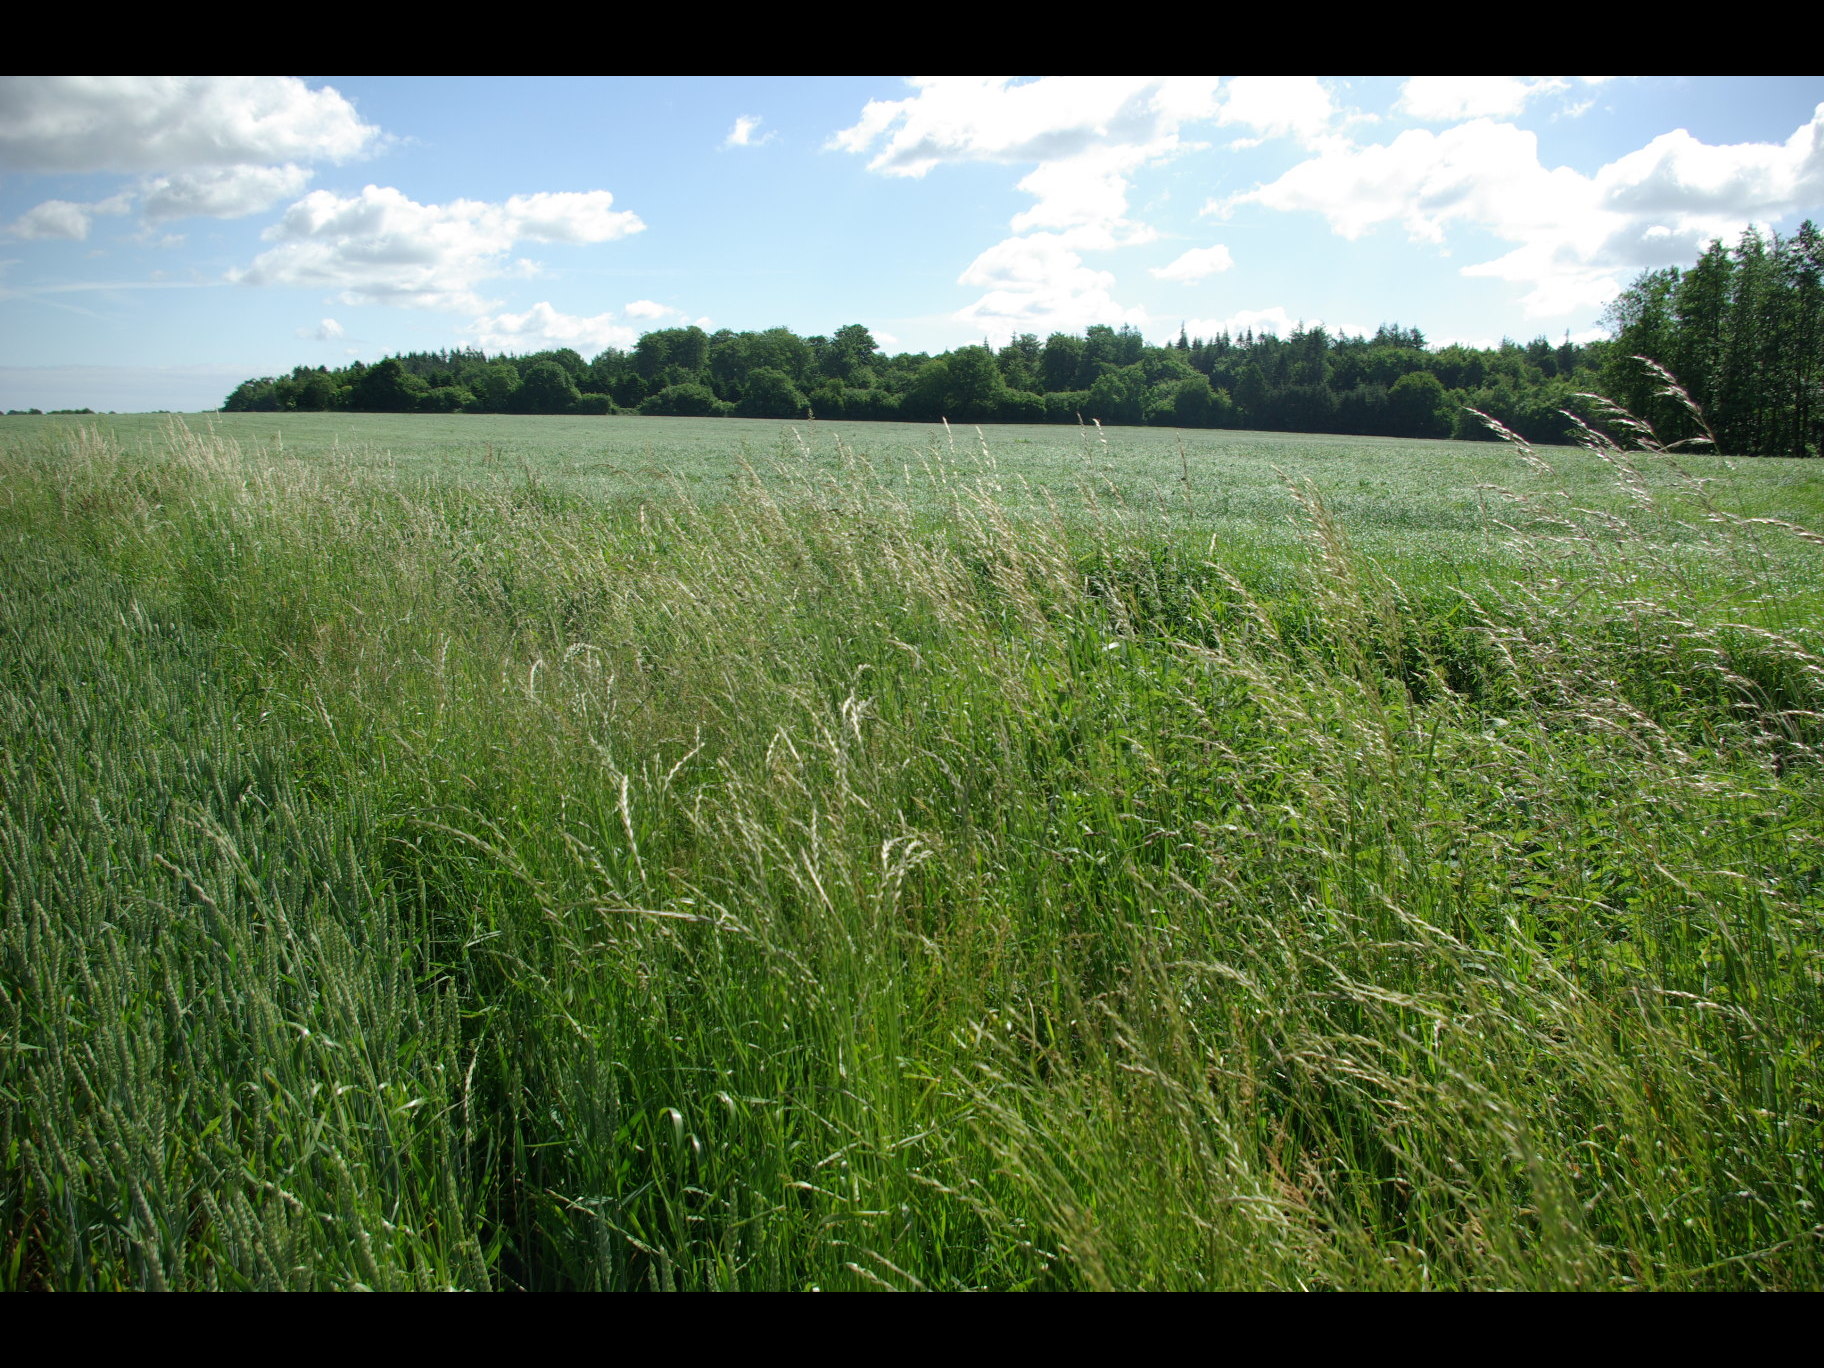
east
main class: Cropland
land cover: Common wheat
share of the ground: > 75 %
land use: Agriculture (excluding fallow land and kitchen gardens)
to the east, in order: Common wheat; Spontaneously vegetated surfaces; Inland fresh running water; Spontaneously vegetated surfaces; Grassland without tree/shrub cover
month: June
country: DE
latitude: 54.3724
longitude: 9.8923
